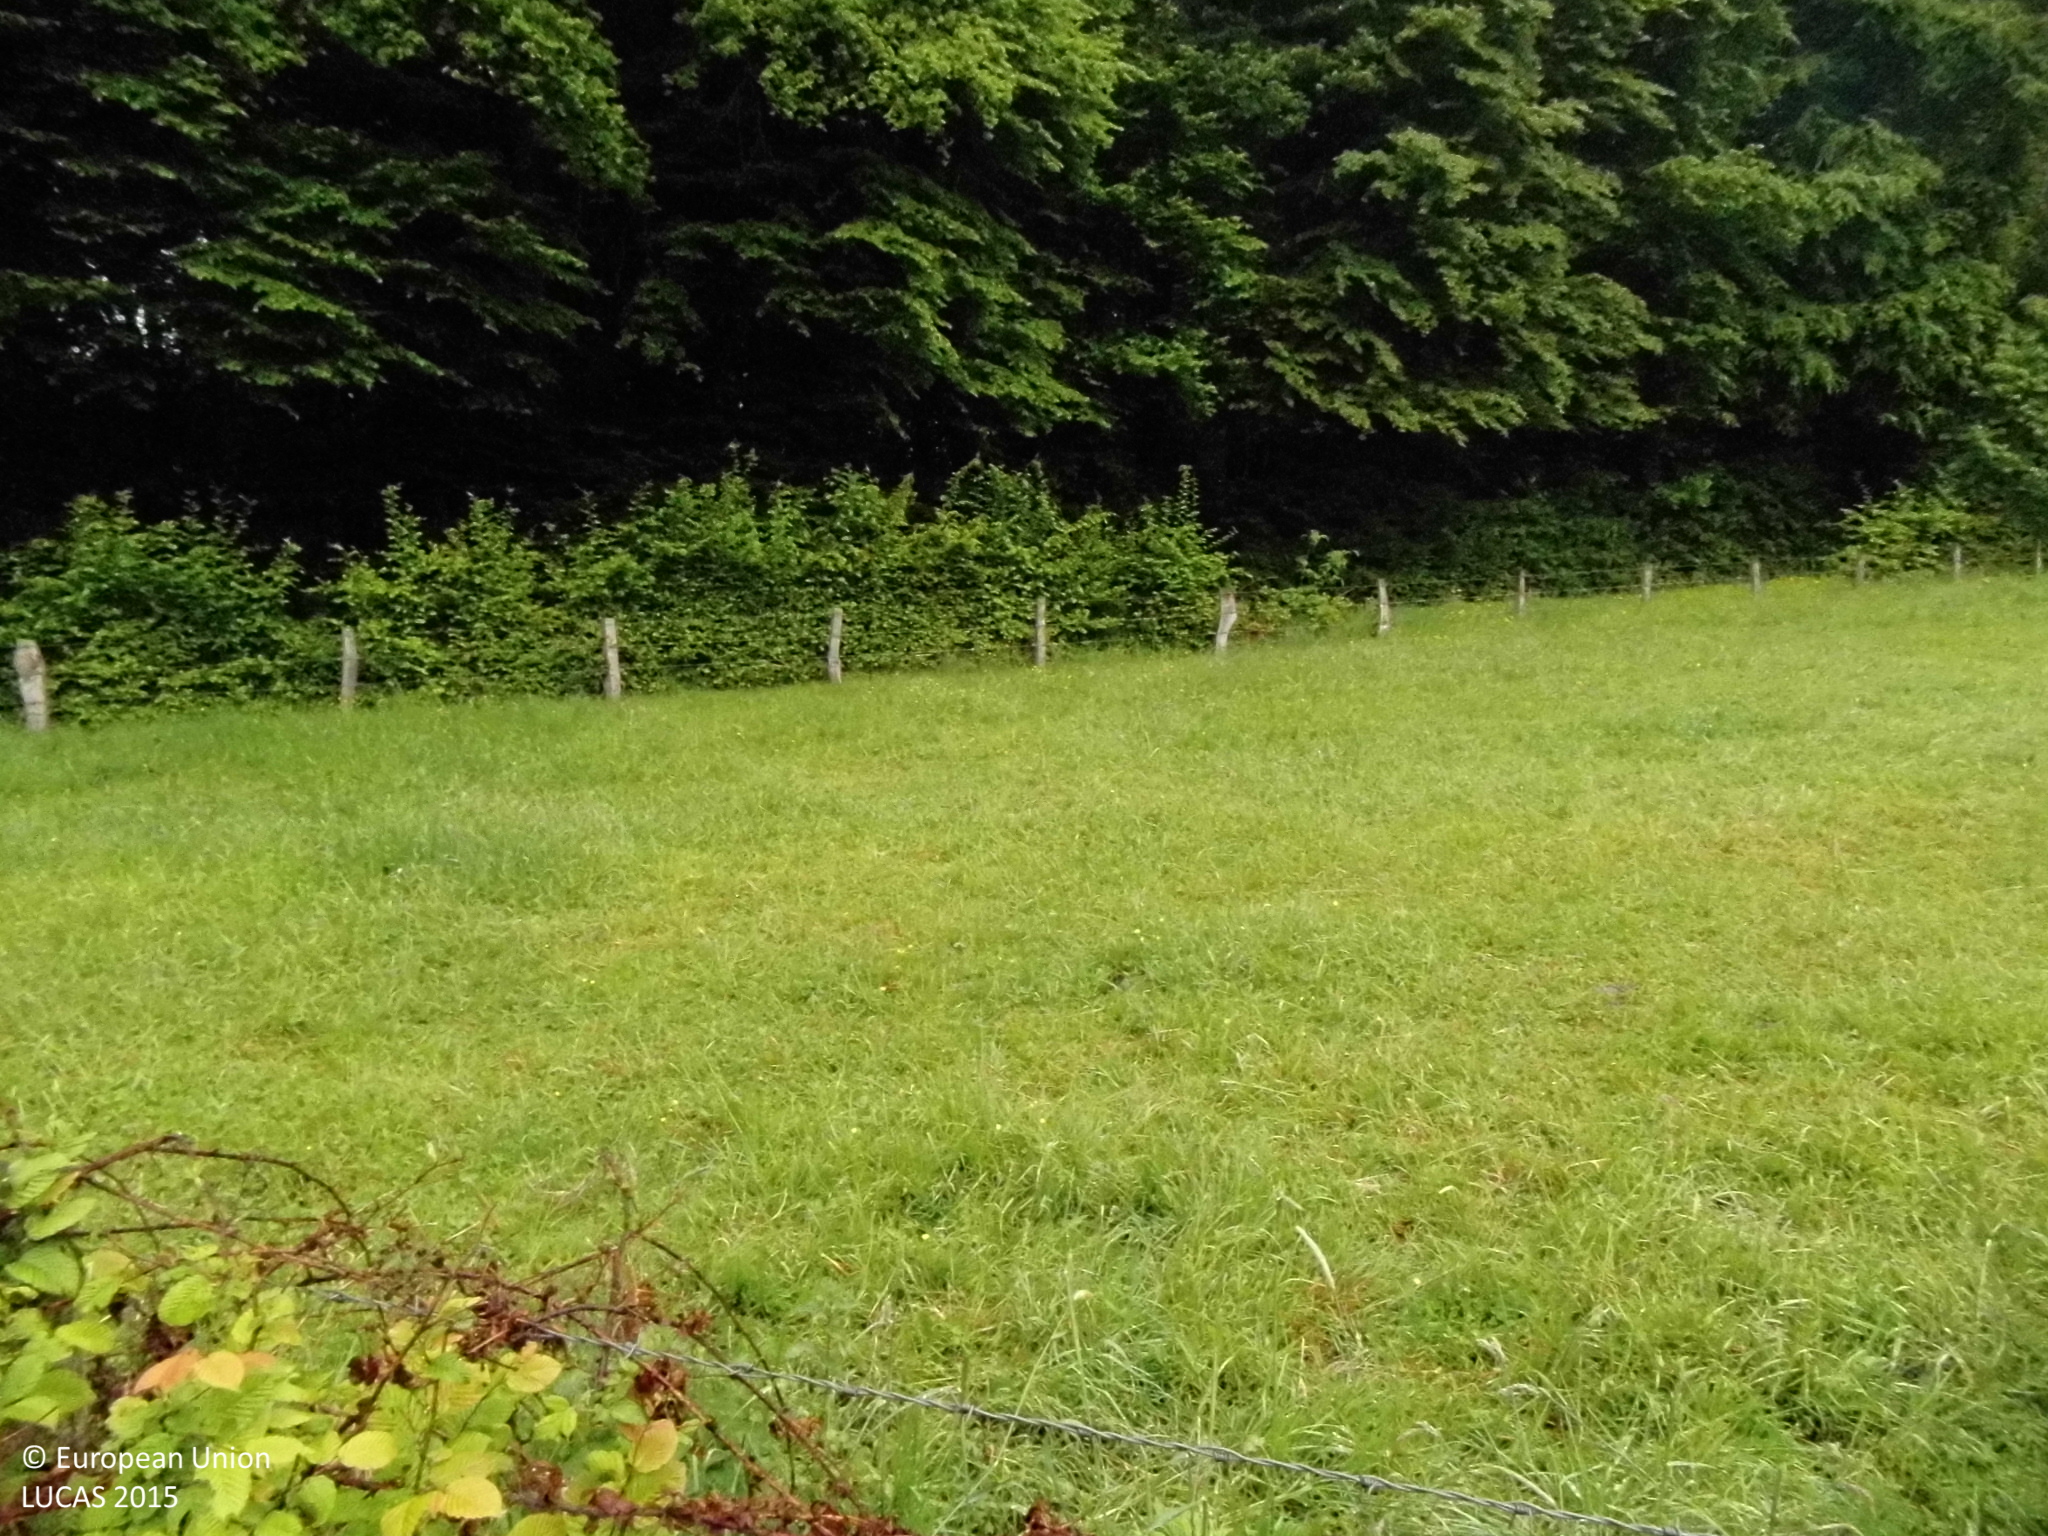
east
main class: Grassland
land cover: Grassland without tree/shrub cover
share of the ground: > 75 %
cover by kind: herbaceous plants 100 %
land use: Agriculture (excluding fallow land and kitchen gardens)
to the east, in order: Grassland without tree/shrub cover; Fences; Groves; Tracks; Broadleaved woodland; Grassland without tree/shrub cover
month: May
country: DE
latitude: 50.6605
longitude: 7.4963
